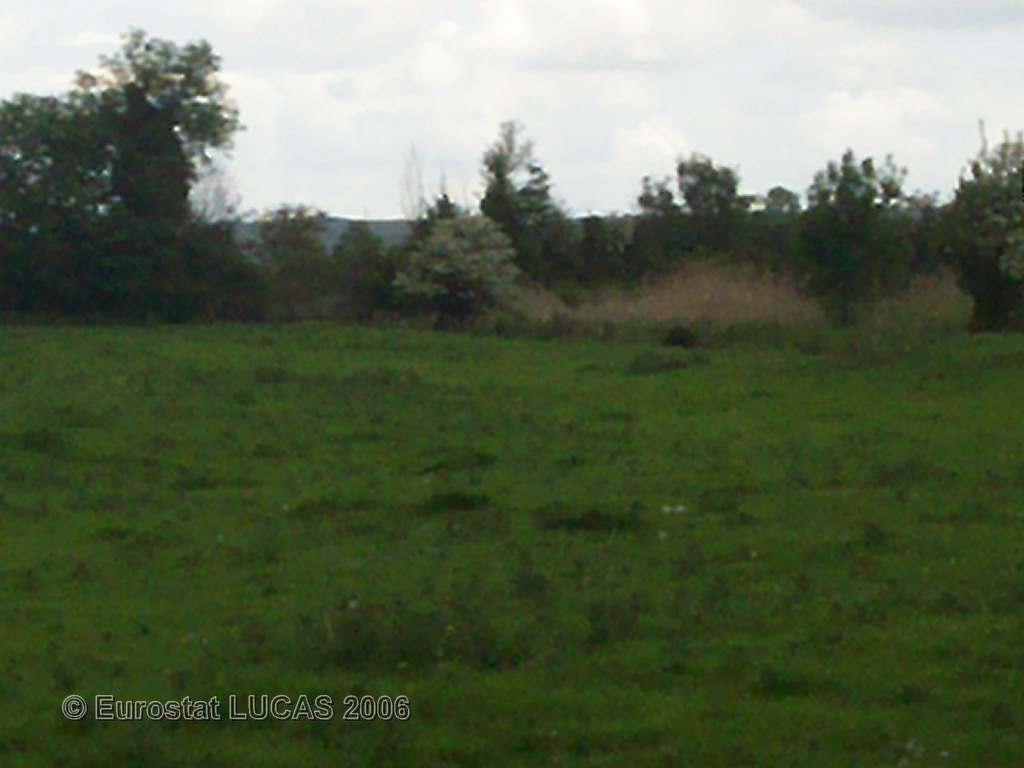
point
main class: Grassland
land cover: Grassland without tree/shrub cover
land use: Agriculture (excluding fallow land and kitchen gardens)
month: May
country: FR
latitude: 49.4379
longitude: 0.4437
